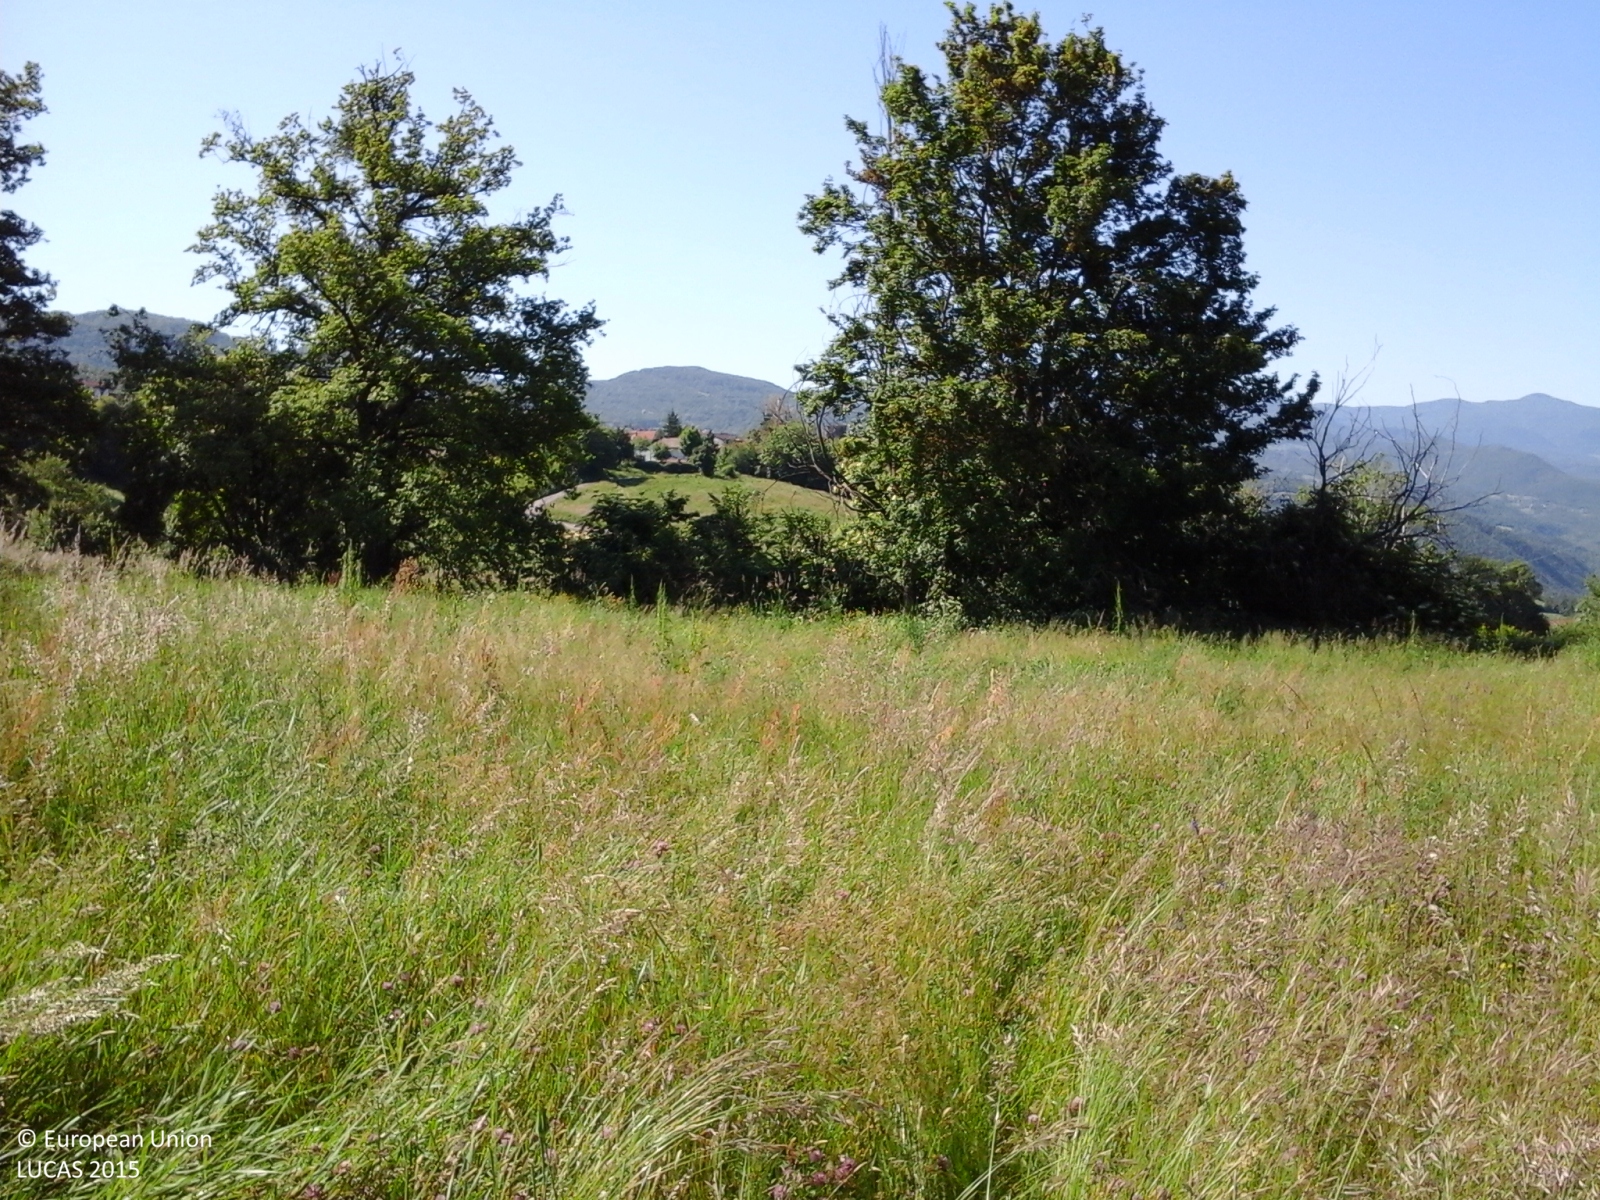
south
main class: Grassland
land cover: Grassland without tree/shrub cover
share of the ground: > 75 %
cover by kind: herbaceous plants 100 %
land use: Agriculture (excluding fallow land and kitchen gardens)
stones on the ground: < 10 %
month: May
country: IT
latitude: 44.3665
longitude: 10.6635
